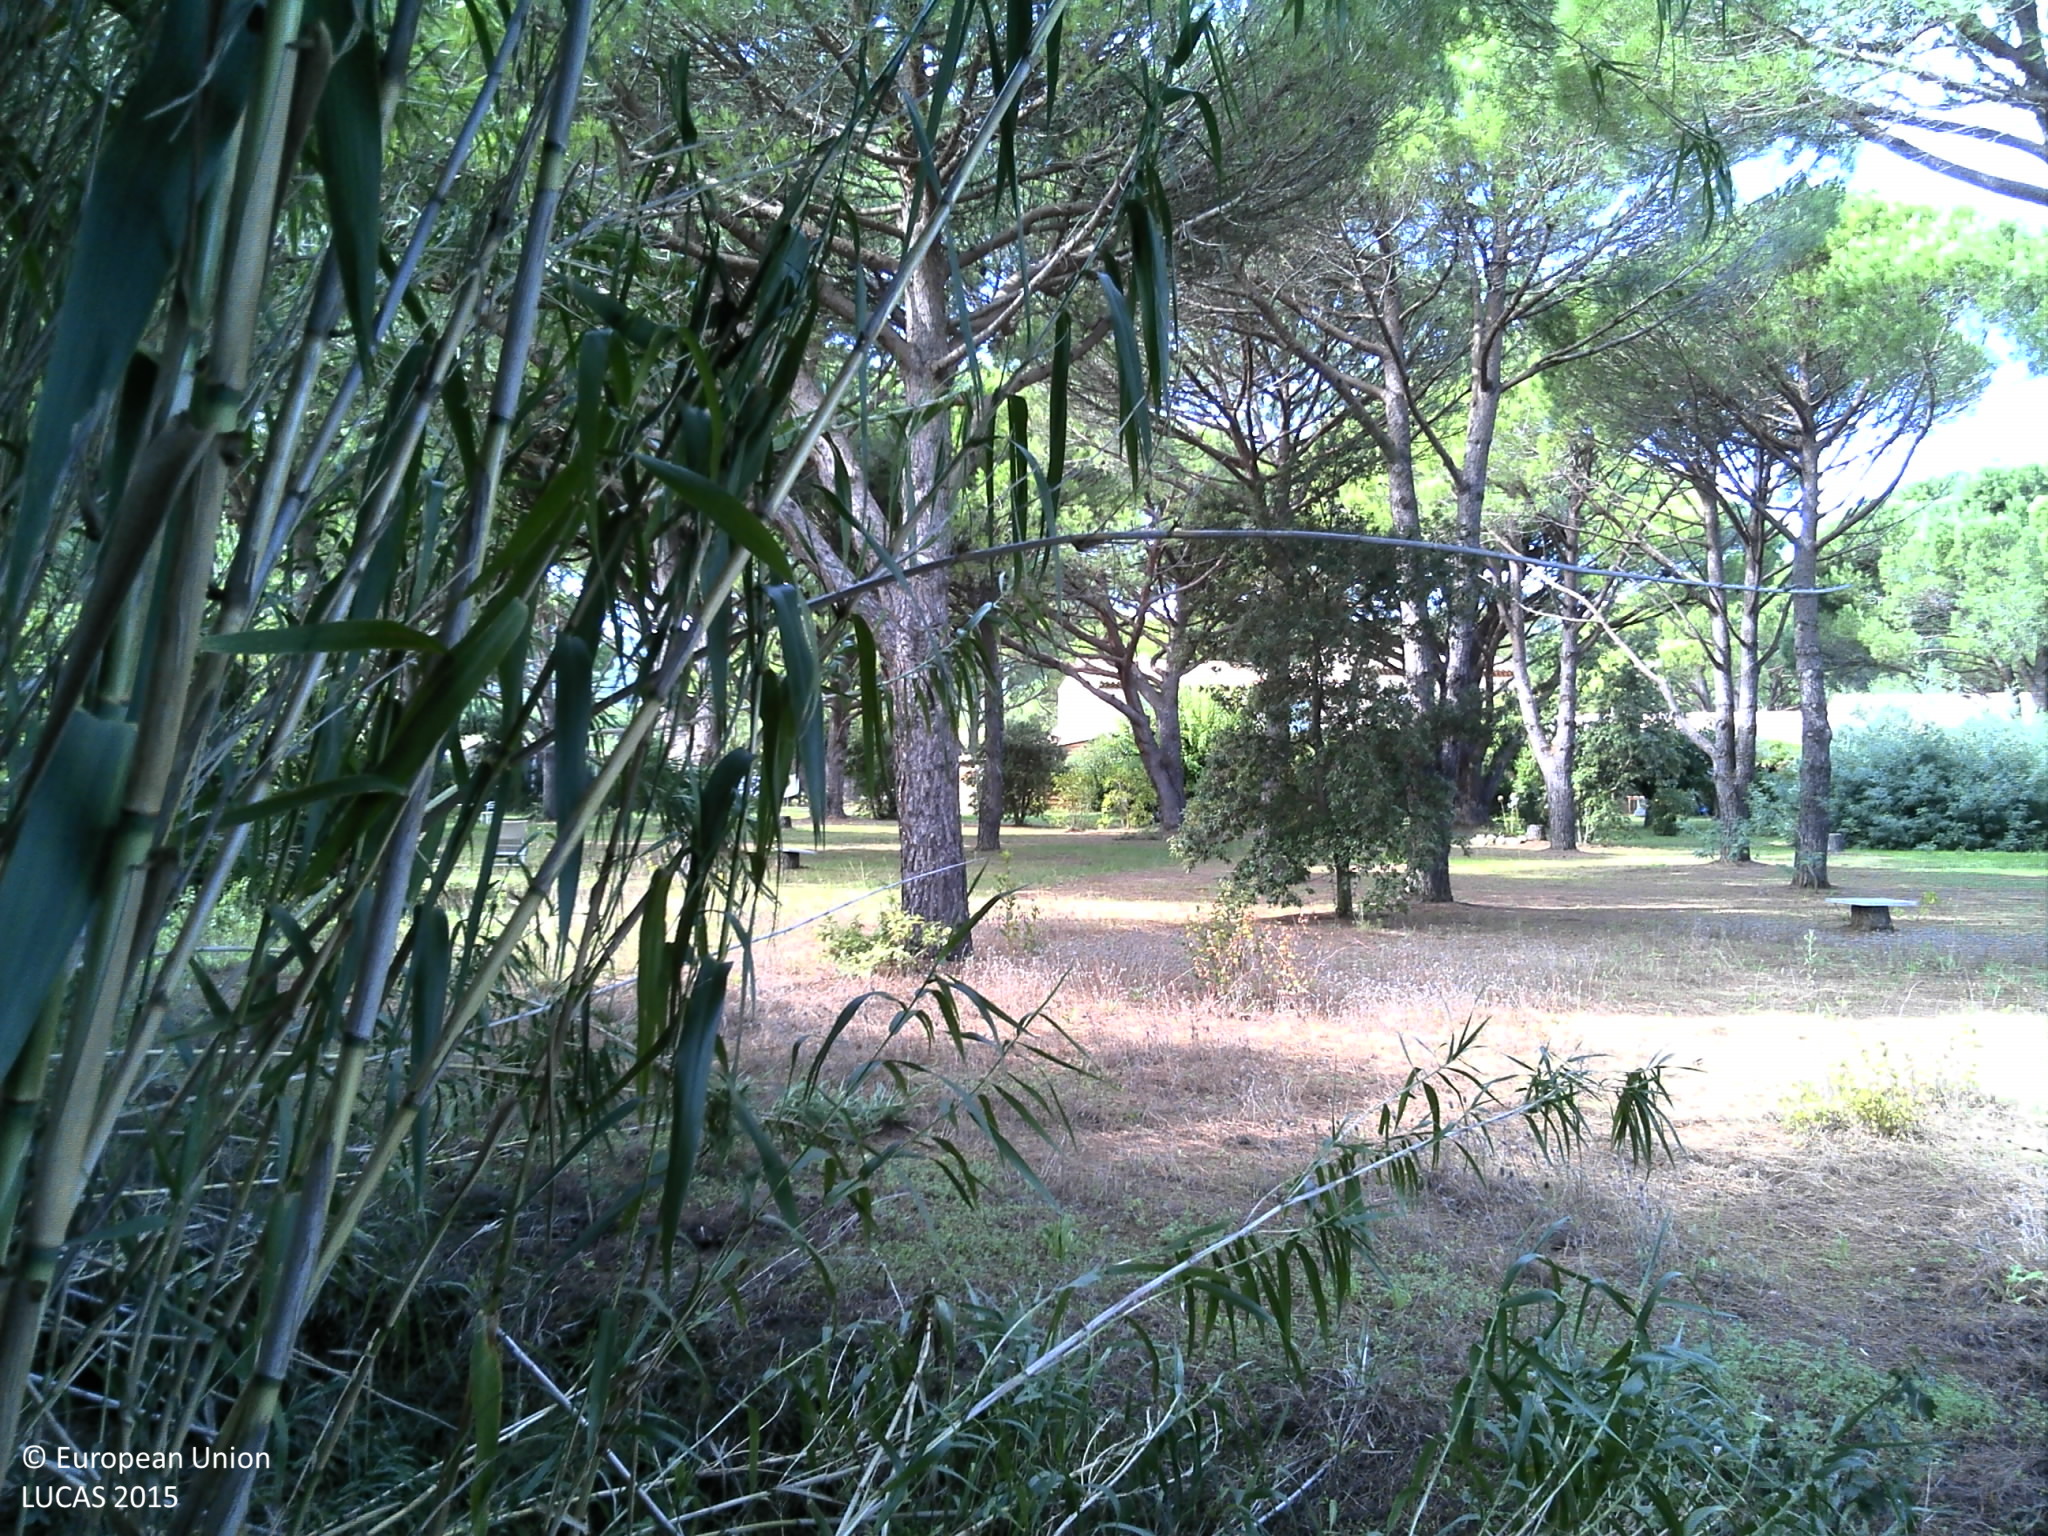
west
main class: Woodland
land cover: Pine dominated coniferous woodland
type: coniferous forest of the mediterranean region
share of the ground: 50 - 75 %
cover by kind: coniferous forest trees 80 %, herbaceous plants 20 %
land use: Residential
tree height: > 5 m
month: October
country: FR
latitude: 43.2130
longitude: 6.6484
